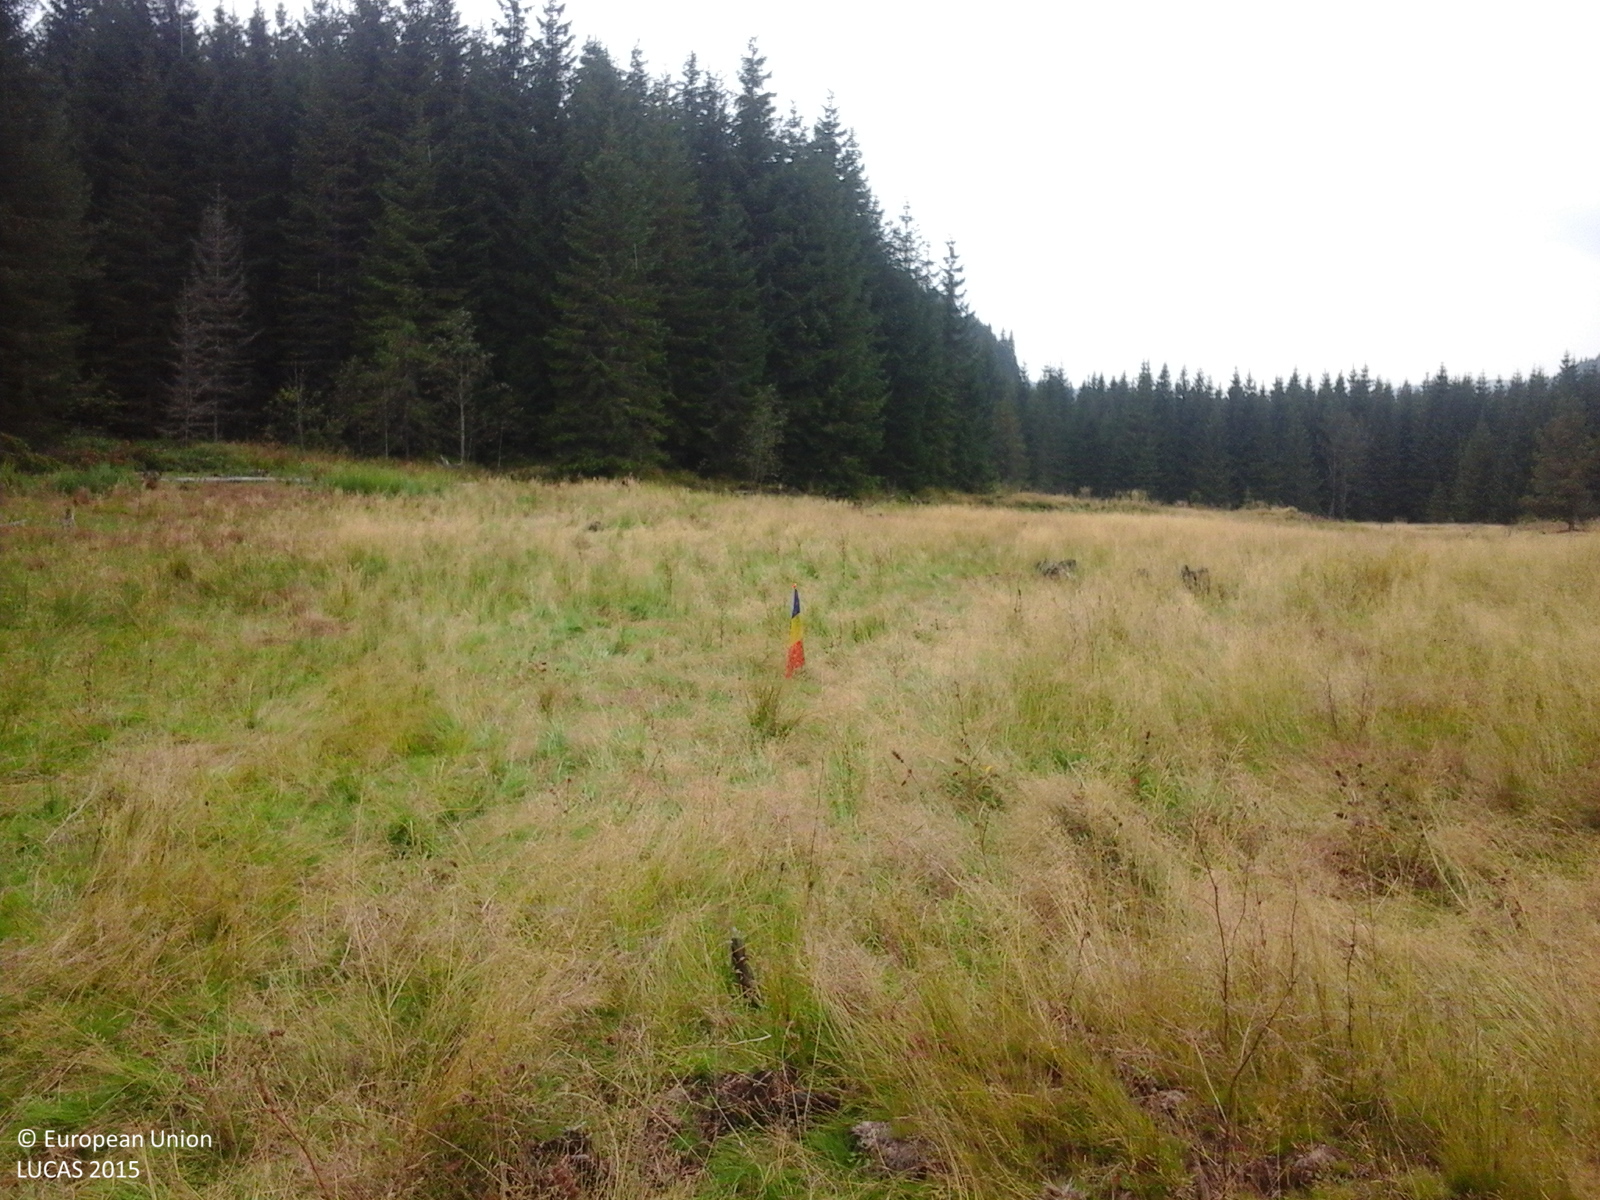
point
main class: Grassland
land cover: Grassland without tree/shrub cover
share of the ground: > 75 %
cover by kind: herbaceous plants 100 %
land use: Agriculture (excluding fallow land and kitchen gardens)
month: September
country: RO
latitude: 45.4312
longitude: 23.6765
